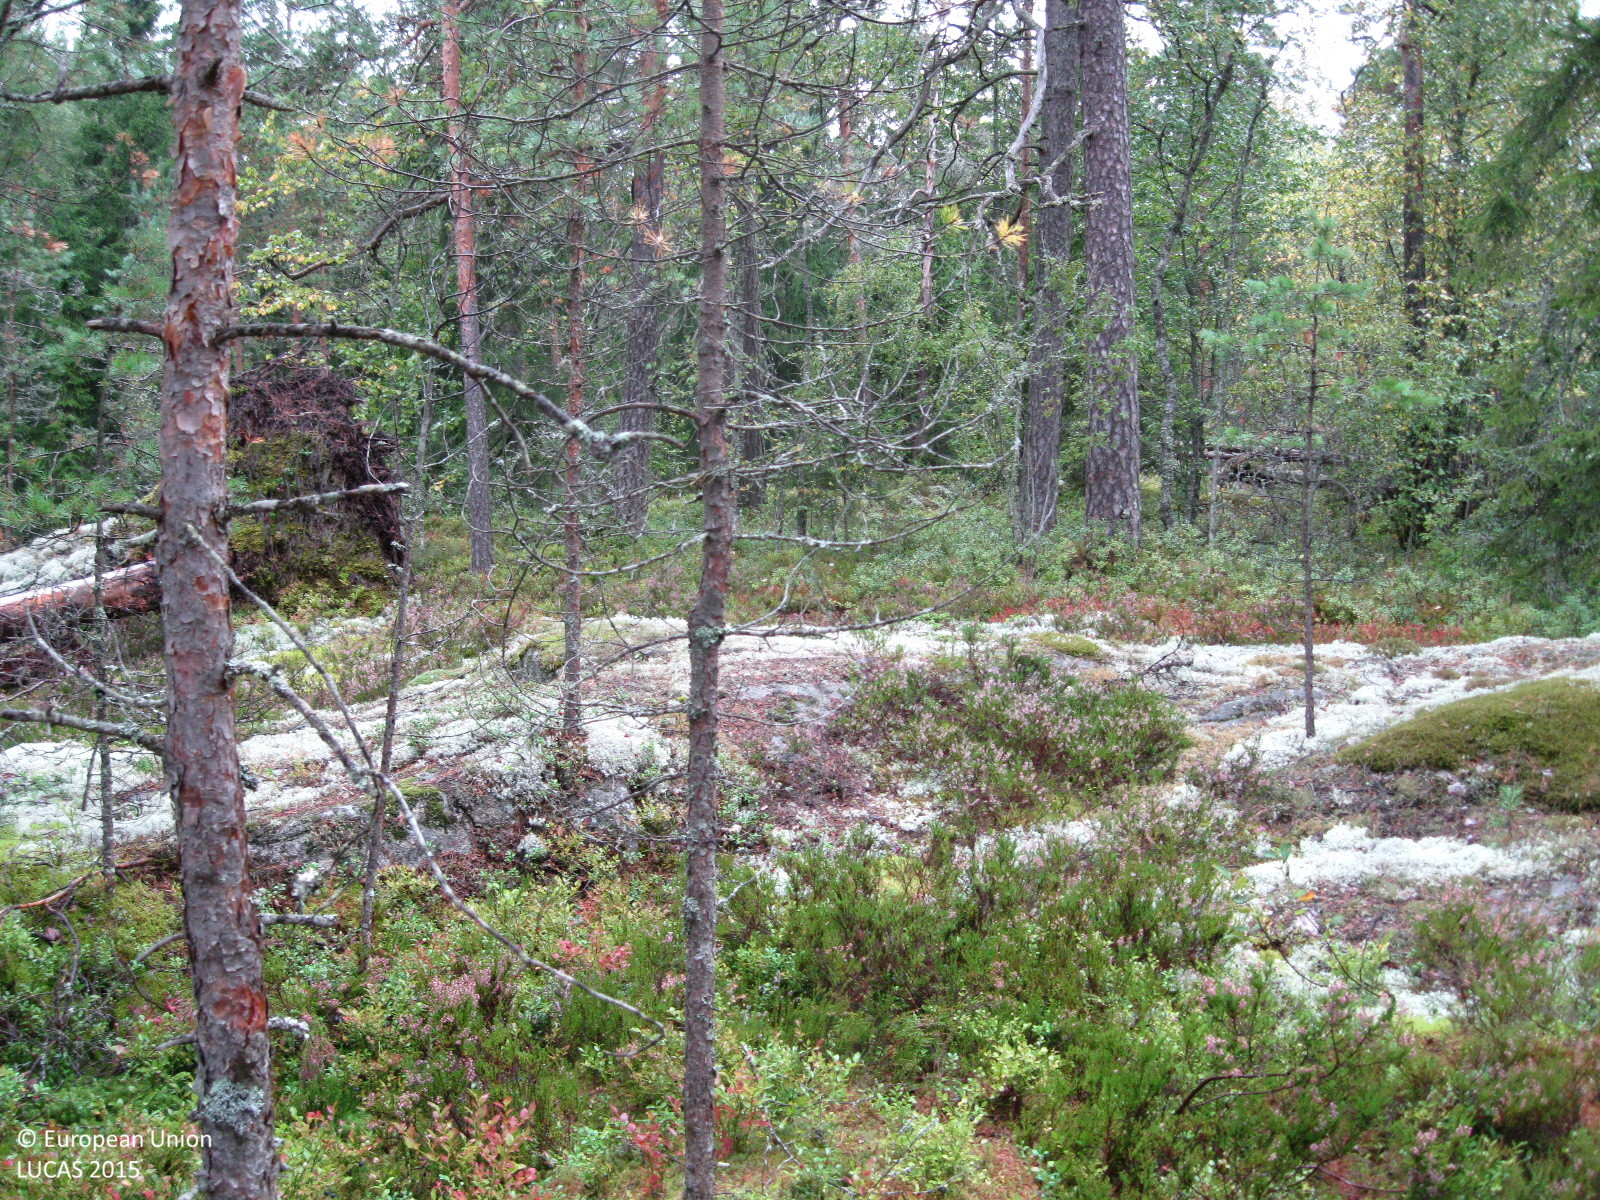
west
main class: Woodland
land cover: Pine dominated coniferous woodland
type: boreal forest
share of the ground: 25 - 50 %
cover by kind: shrubs 50 %, coniferous forest trees 25 %, herbaceous plants 20 %, lichens and mosses 5 %
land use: Forestry
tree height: > 5 m
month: September
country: FI
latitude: 60.2748
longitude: 24.6292
